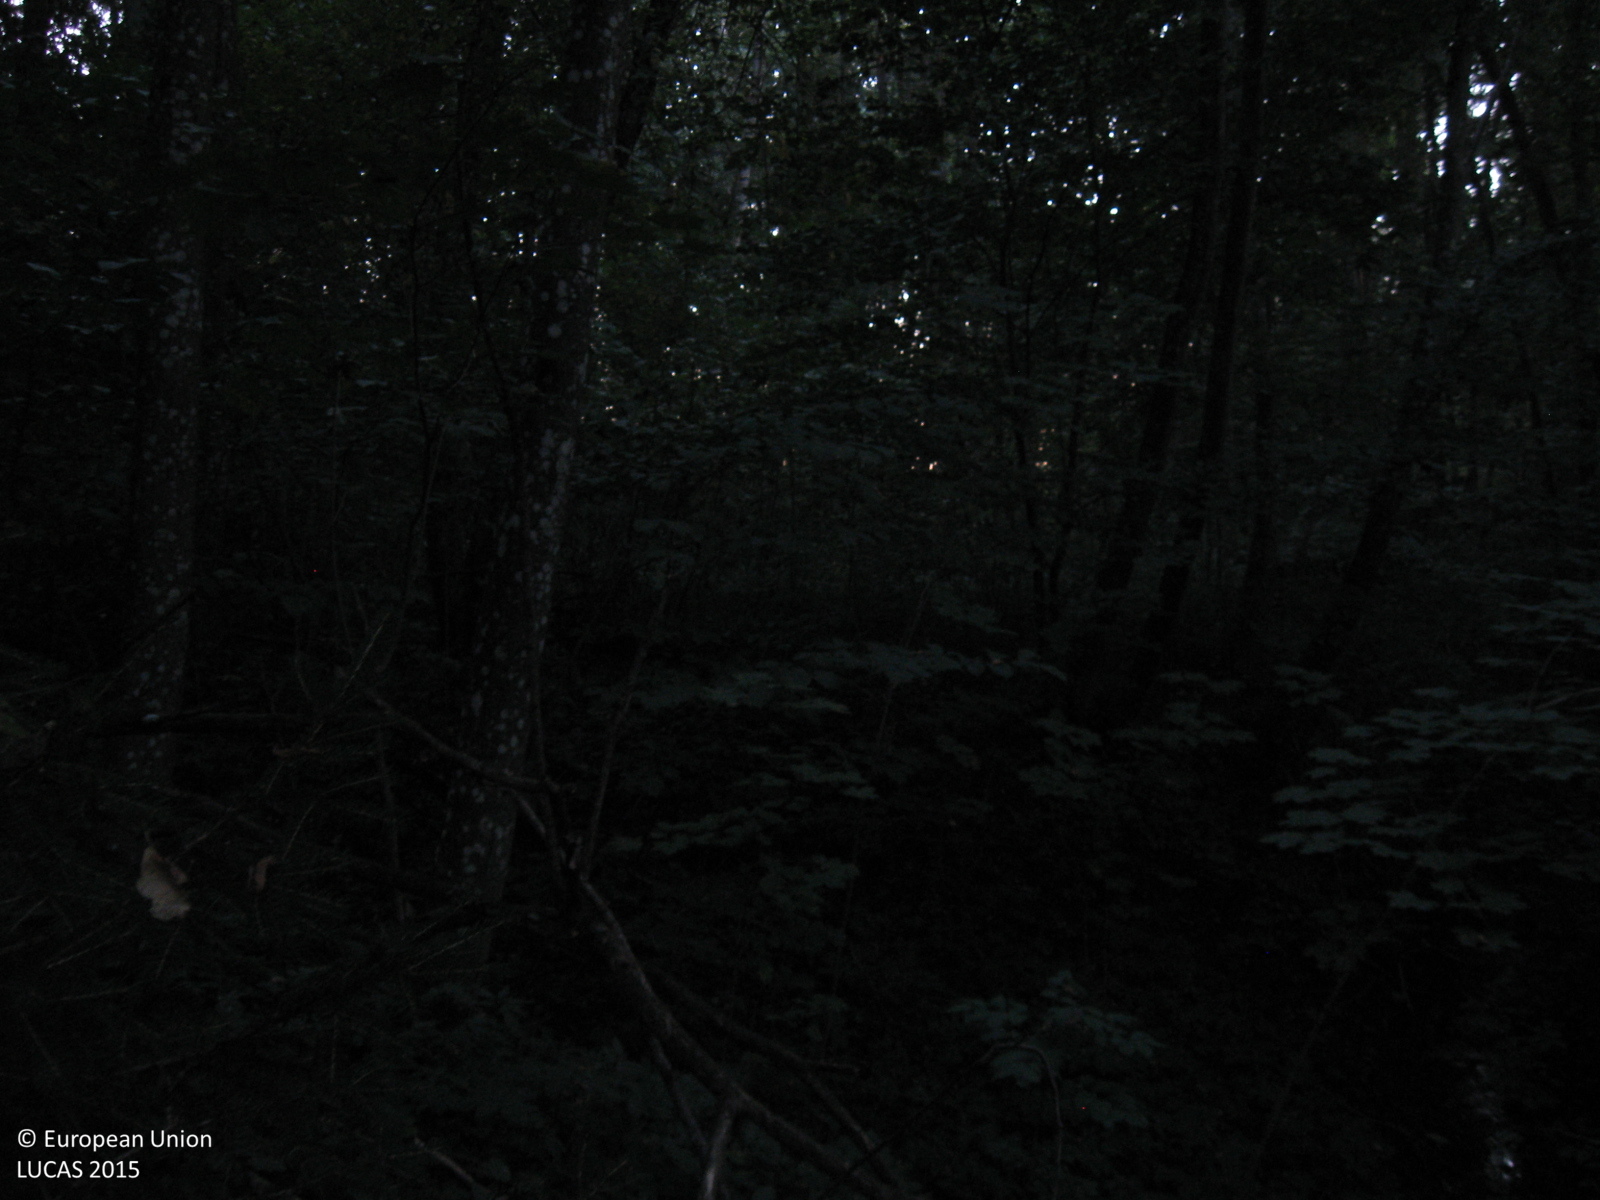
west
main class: Woodland
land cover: Broadleaved woodland
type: floodplain forest
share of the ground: > 75 %
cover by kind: broadleaved forest trees 90 %, coniferous forest trees 5 %, herbaceous plants 5 %
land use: Forestry
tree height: > 5 m
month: August
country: LT
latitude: 55.4988
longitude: 23.2288
